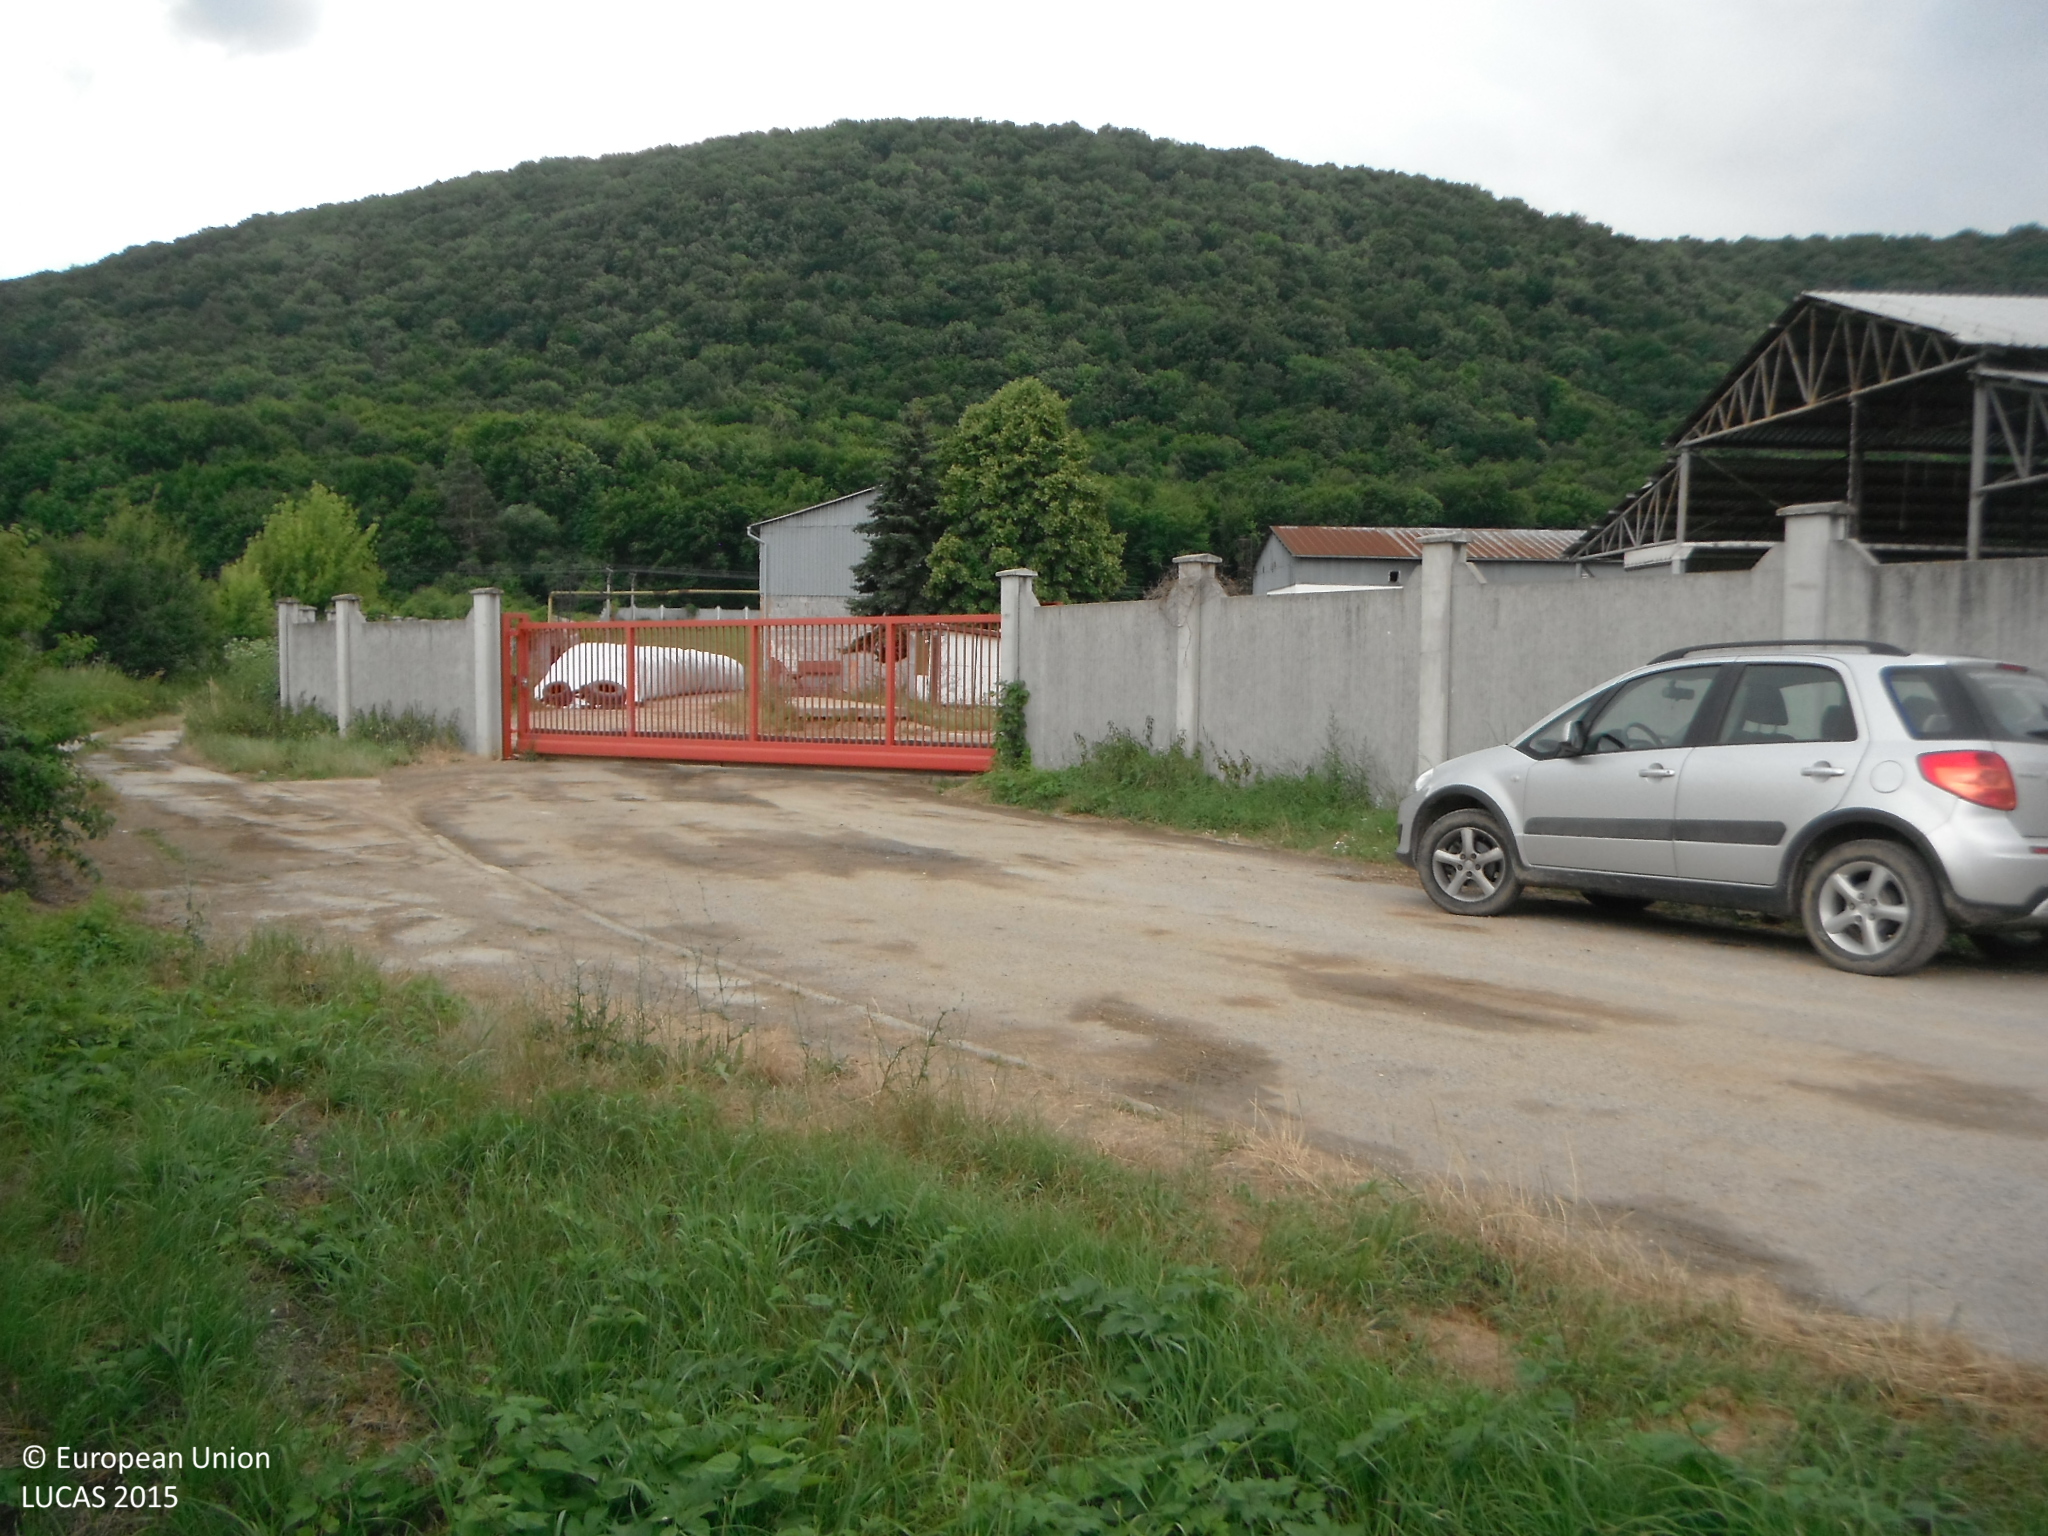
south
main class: Grassland
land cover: Spontaneously vegetated surfaces
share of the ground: > 75 %
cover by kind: herbaceous plants 95 %, shrubs 5 %
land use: Abandoned areas
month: June
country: SK
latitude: 48.6985
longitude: 18.3996
